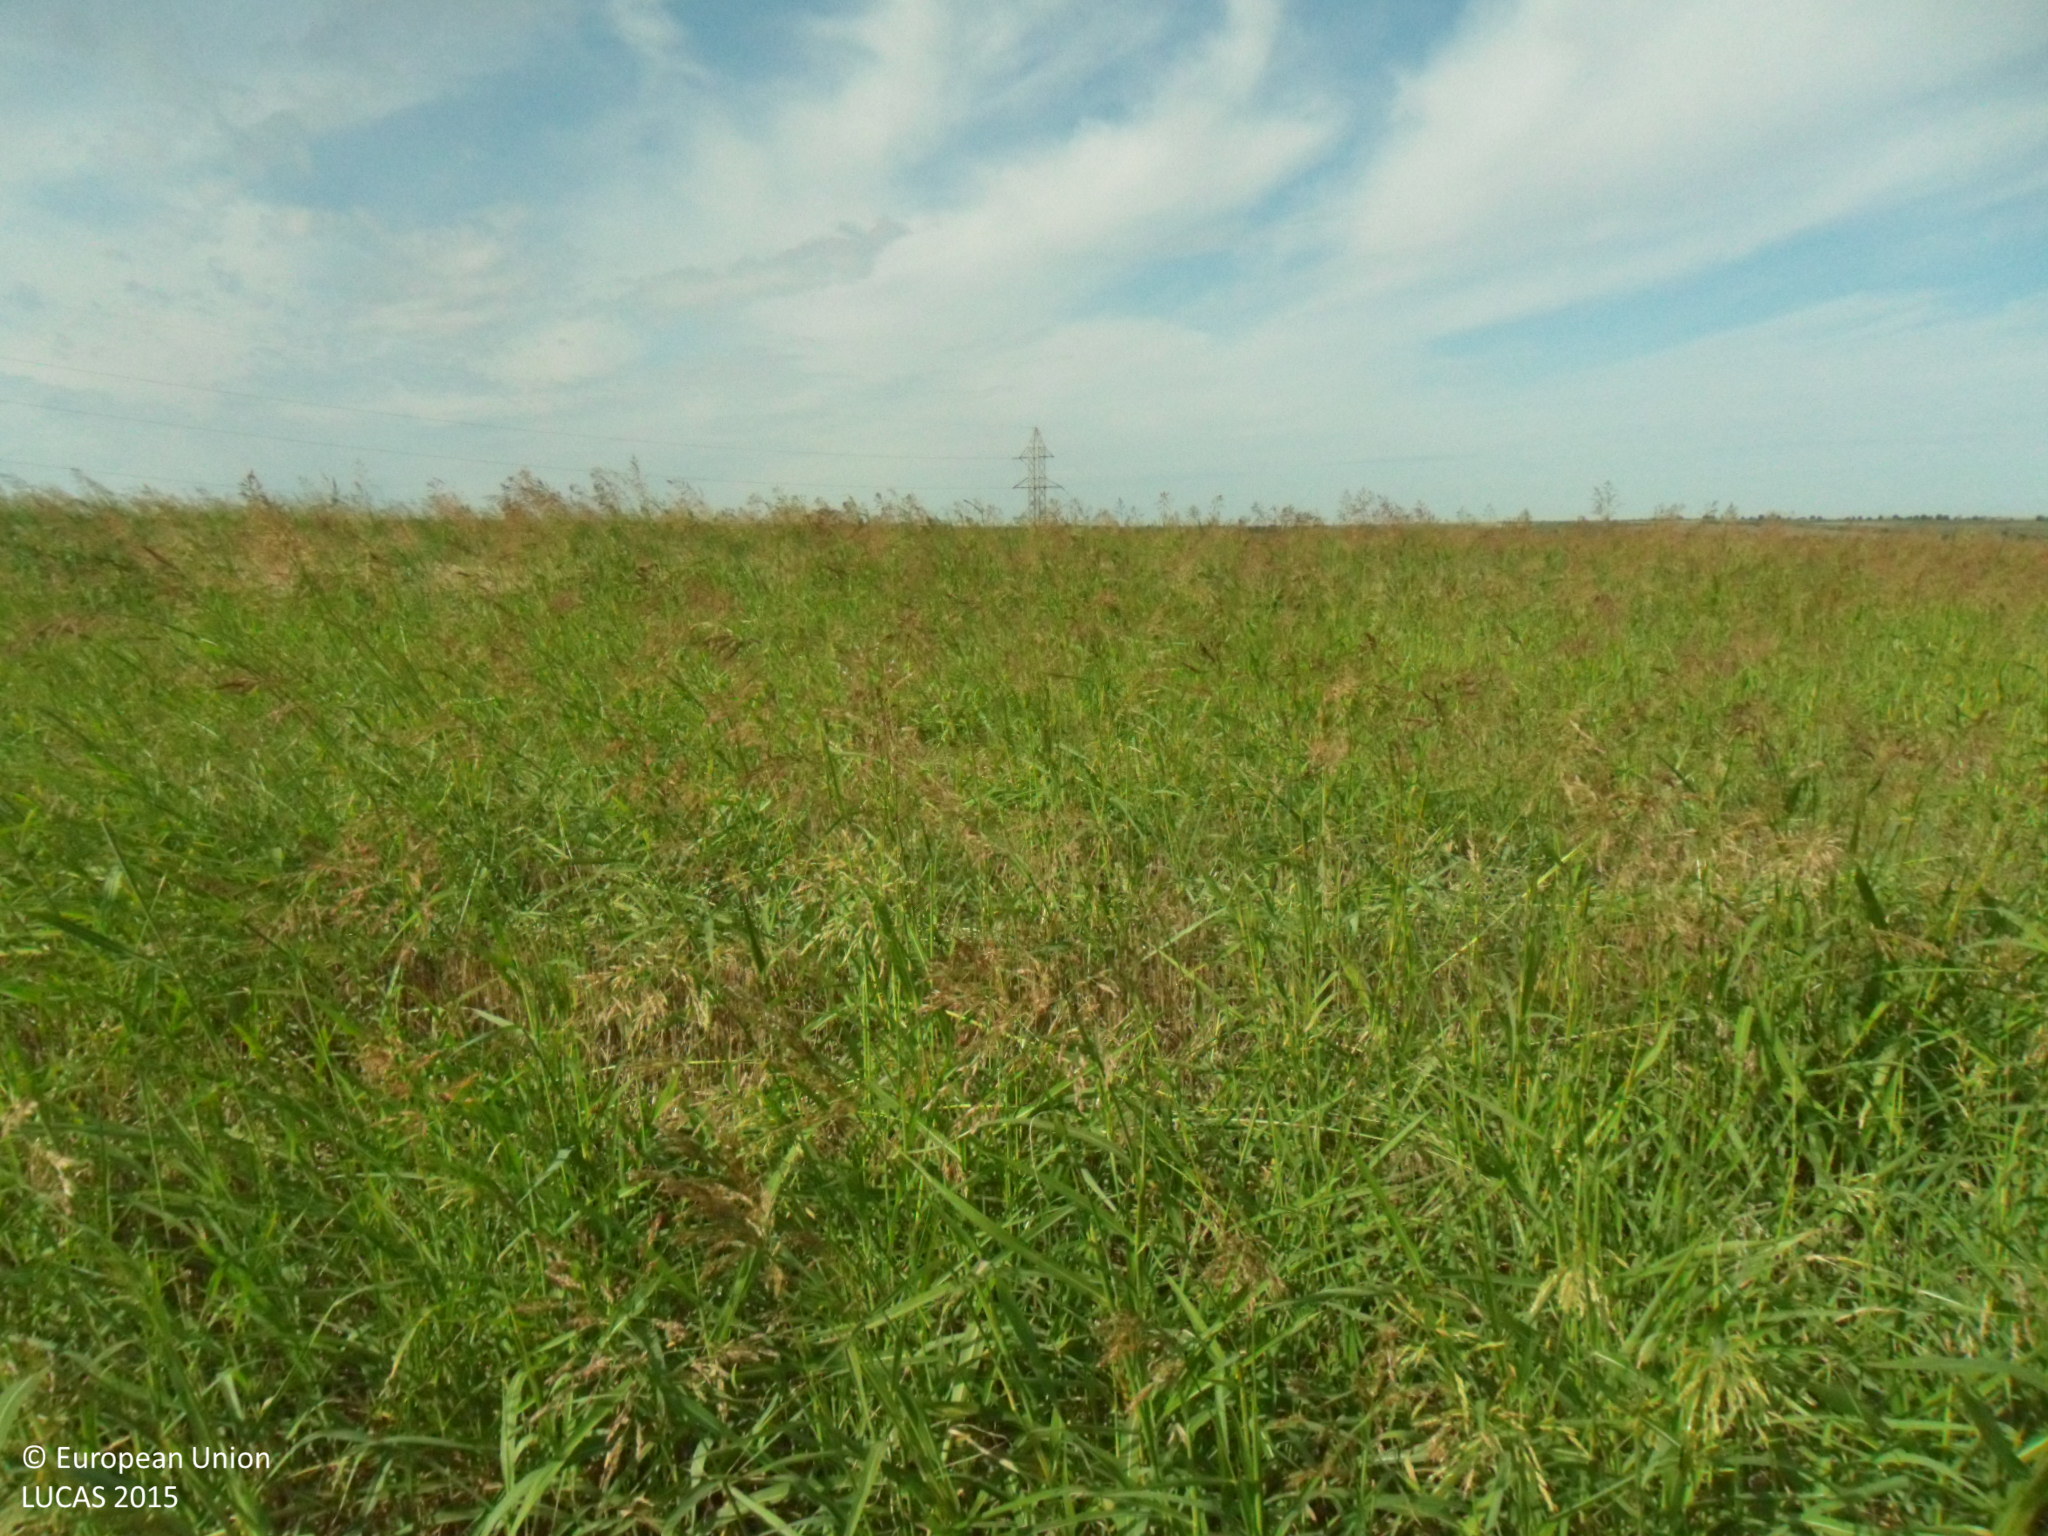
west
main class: Cropland
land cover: Common wheat
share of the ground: < 10 %
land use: Agriculture (excluding fallow land and kitchen gardens)
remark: Harvested field
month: September
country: BG
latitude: 43.5899
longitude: 26.2635
